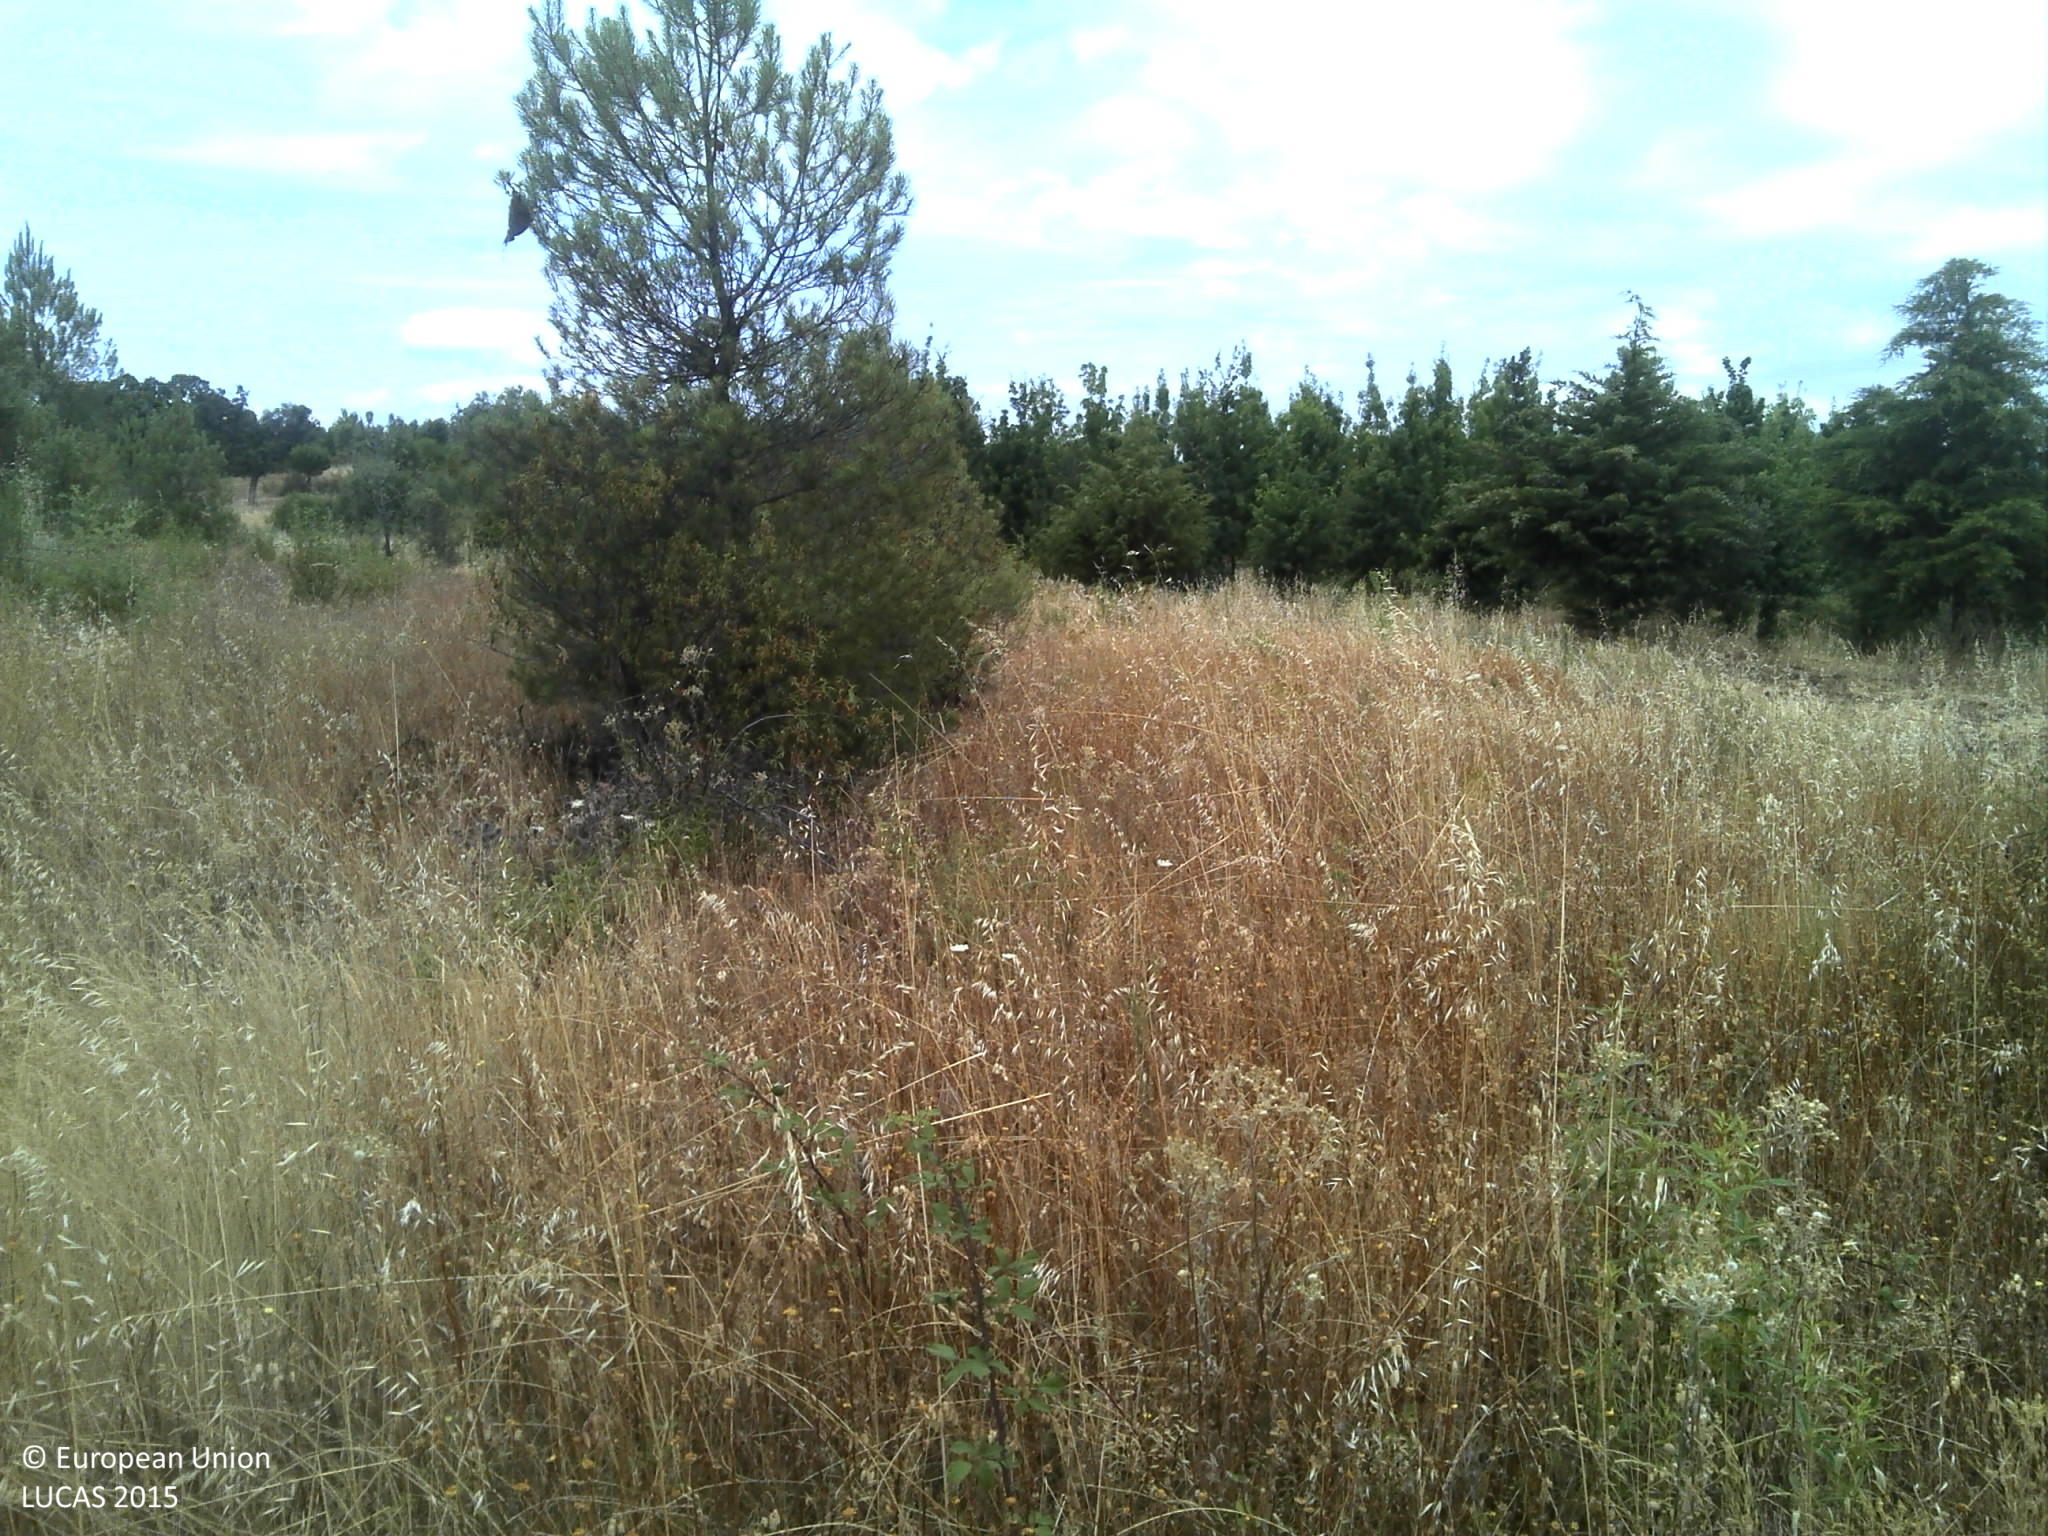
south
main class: Woodland
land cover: Pine dominated coniferous woodland
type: coniferous forest of the mediterranean region
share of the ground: 25 - 50 %
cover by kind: coniferous forest trees 45 %, herbaceous plants 35 %, unconsolidated bare surface 20 %
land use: Forestry
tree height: < 5 m
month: June
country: PT
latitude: 40.1471
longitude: -7.2487
